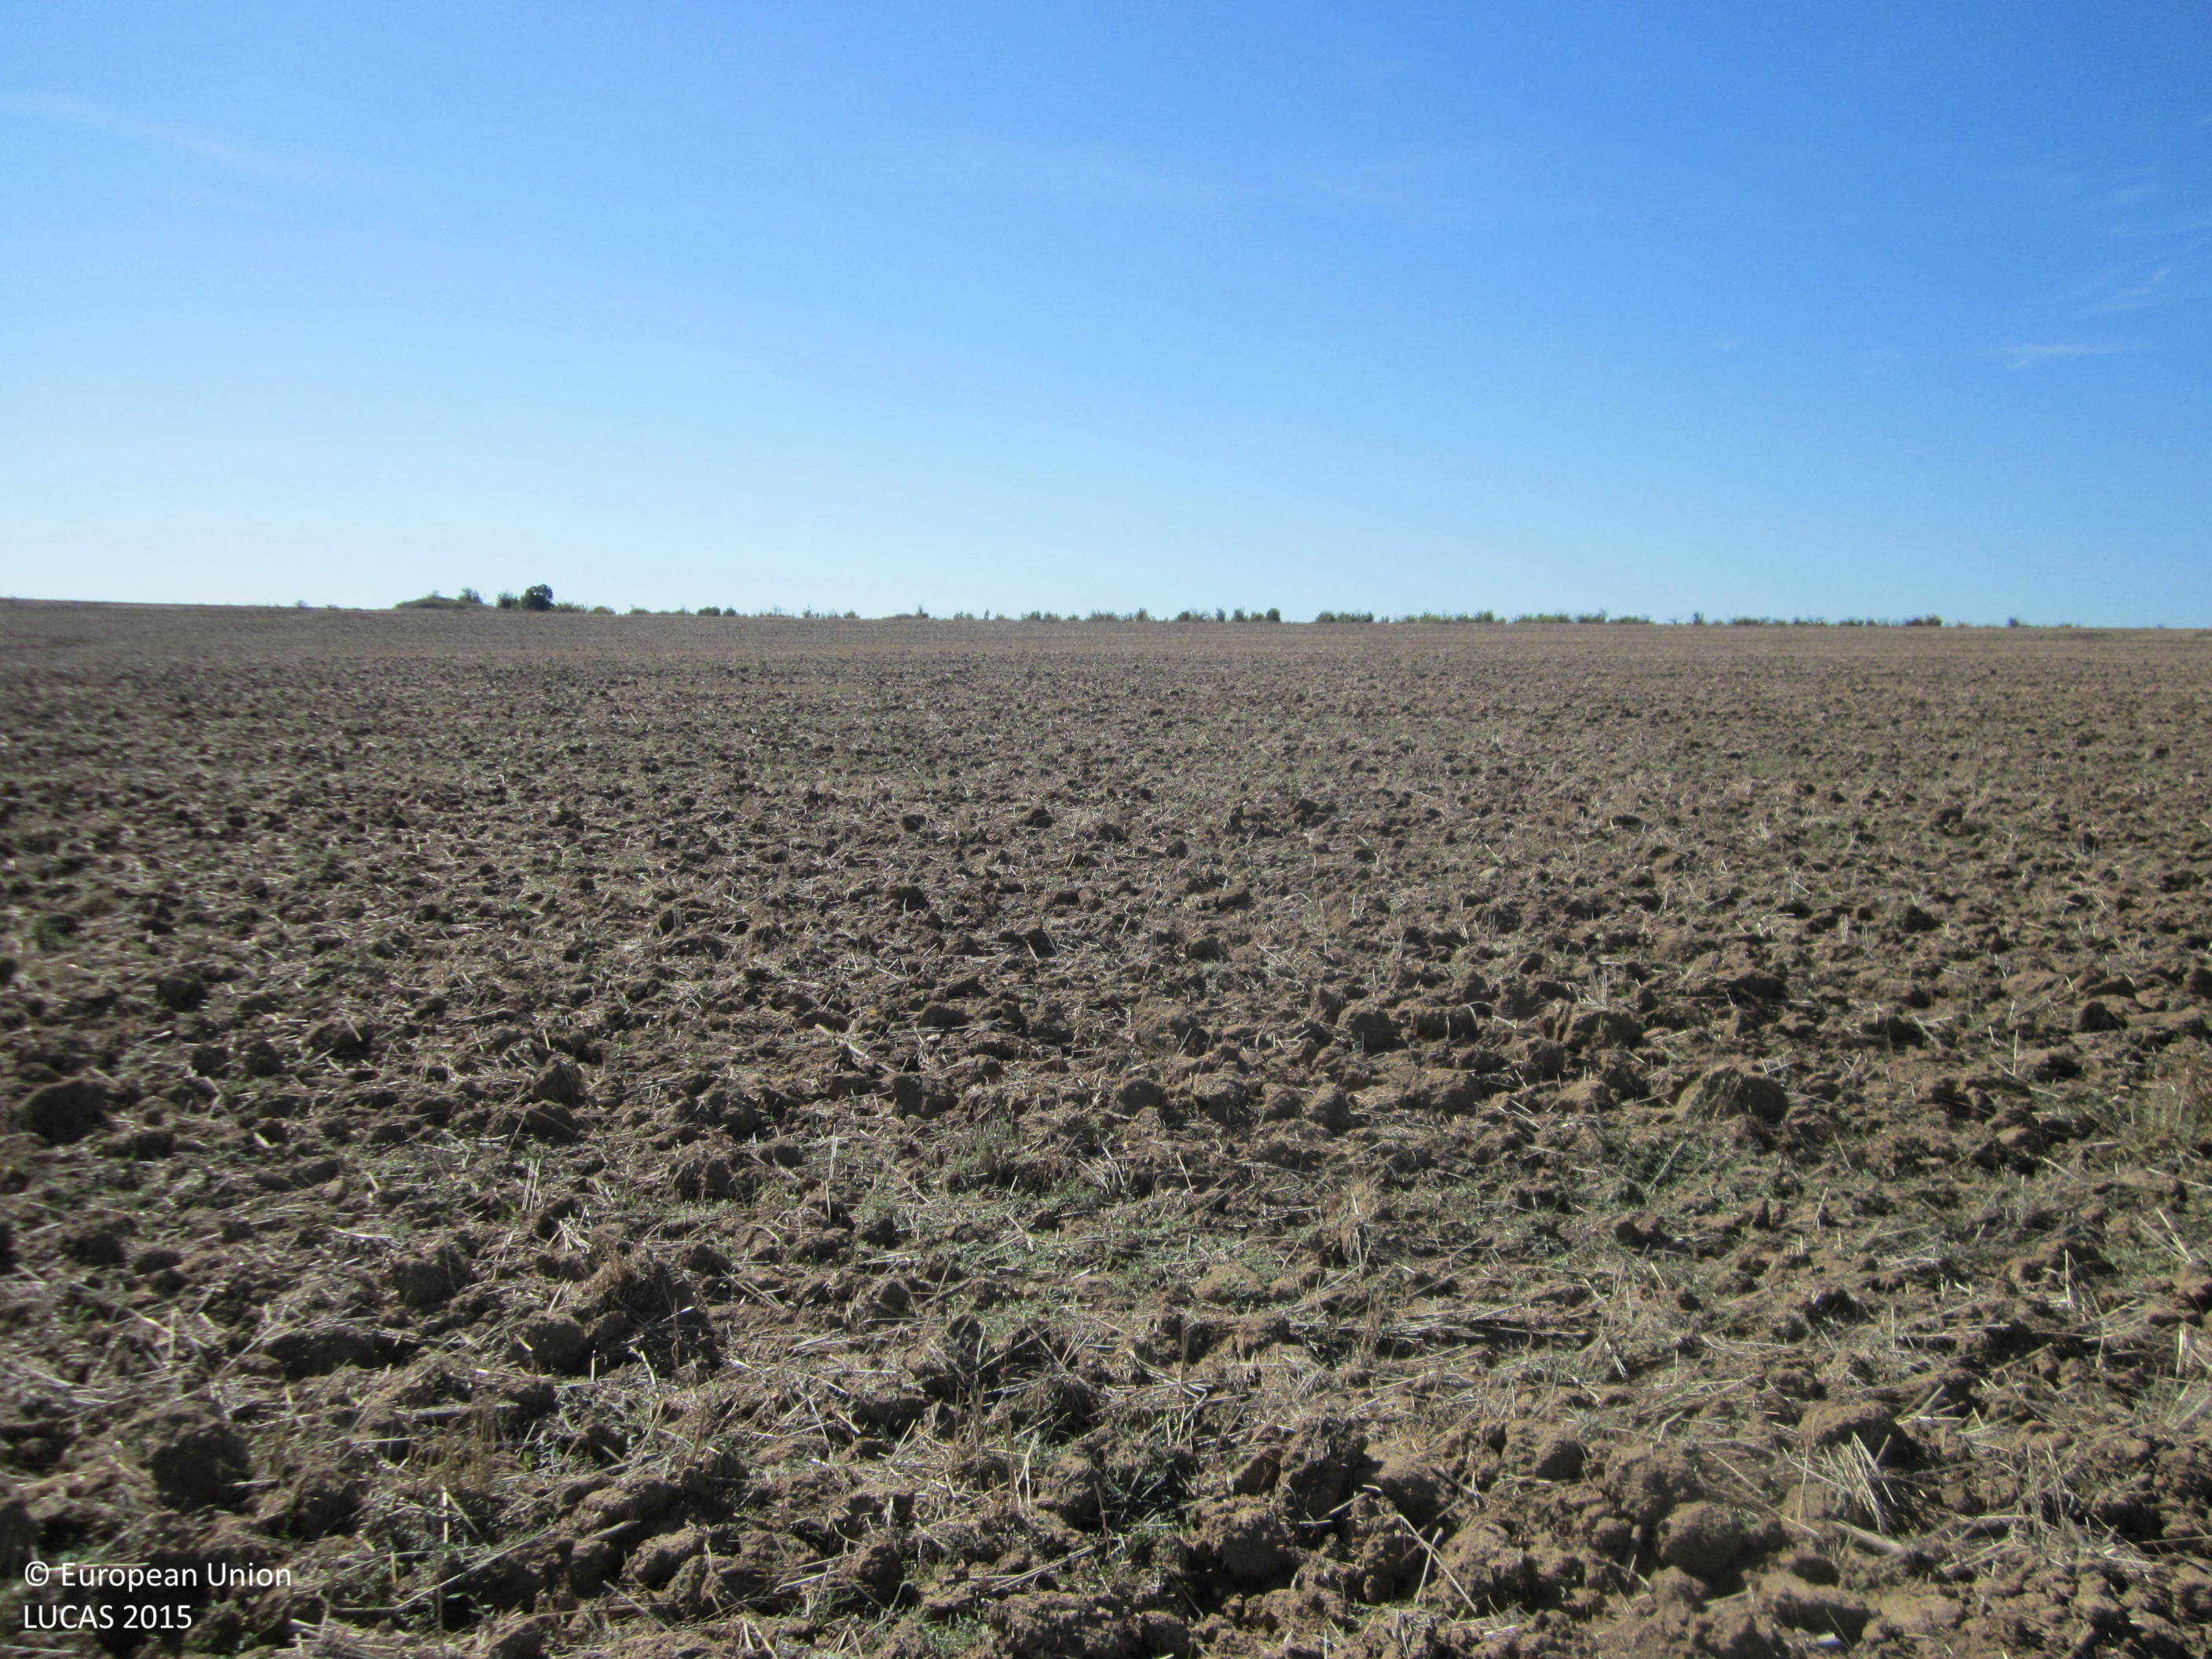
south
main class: Cropland
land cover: Common wheat
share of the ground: < 10 %
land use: Agriculture (excluding fallow land and kitchen gardens)
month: September
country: BG
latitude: 42.1471
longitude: 26.9798
